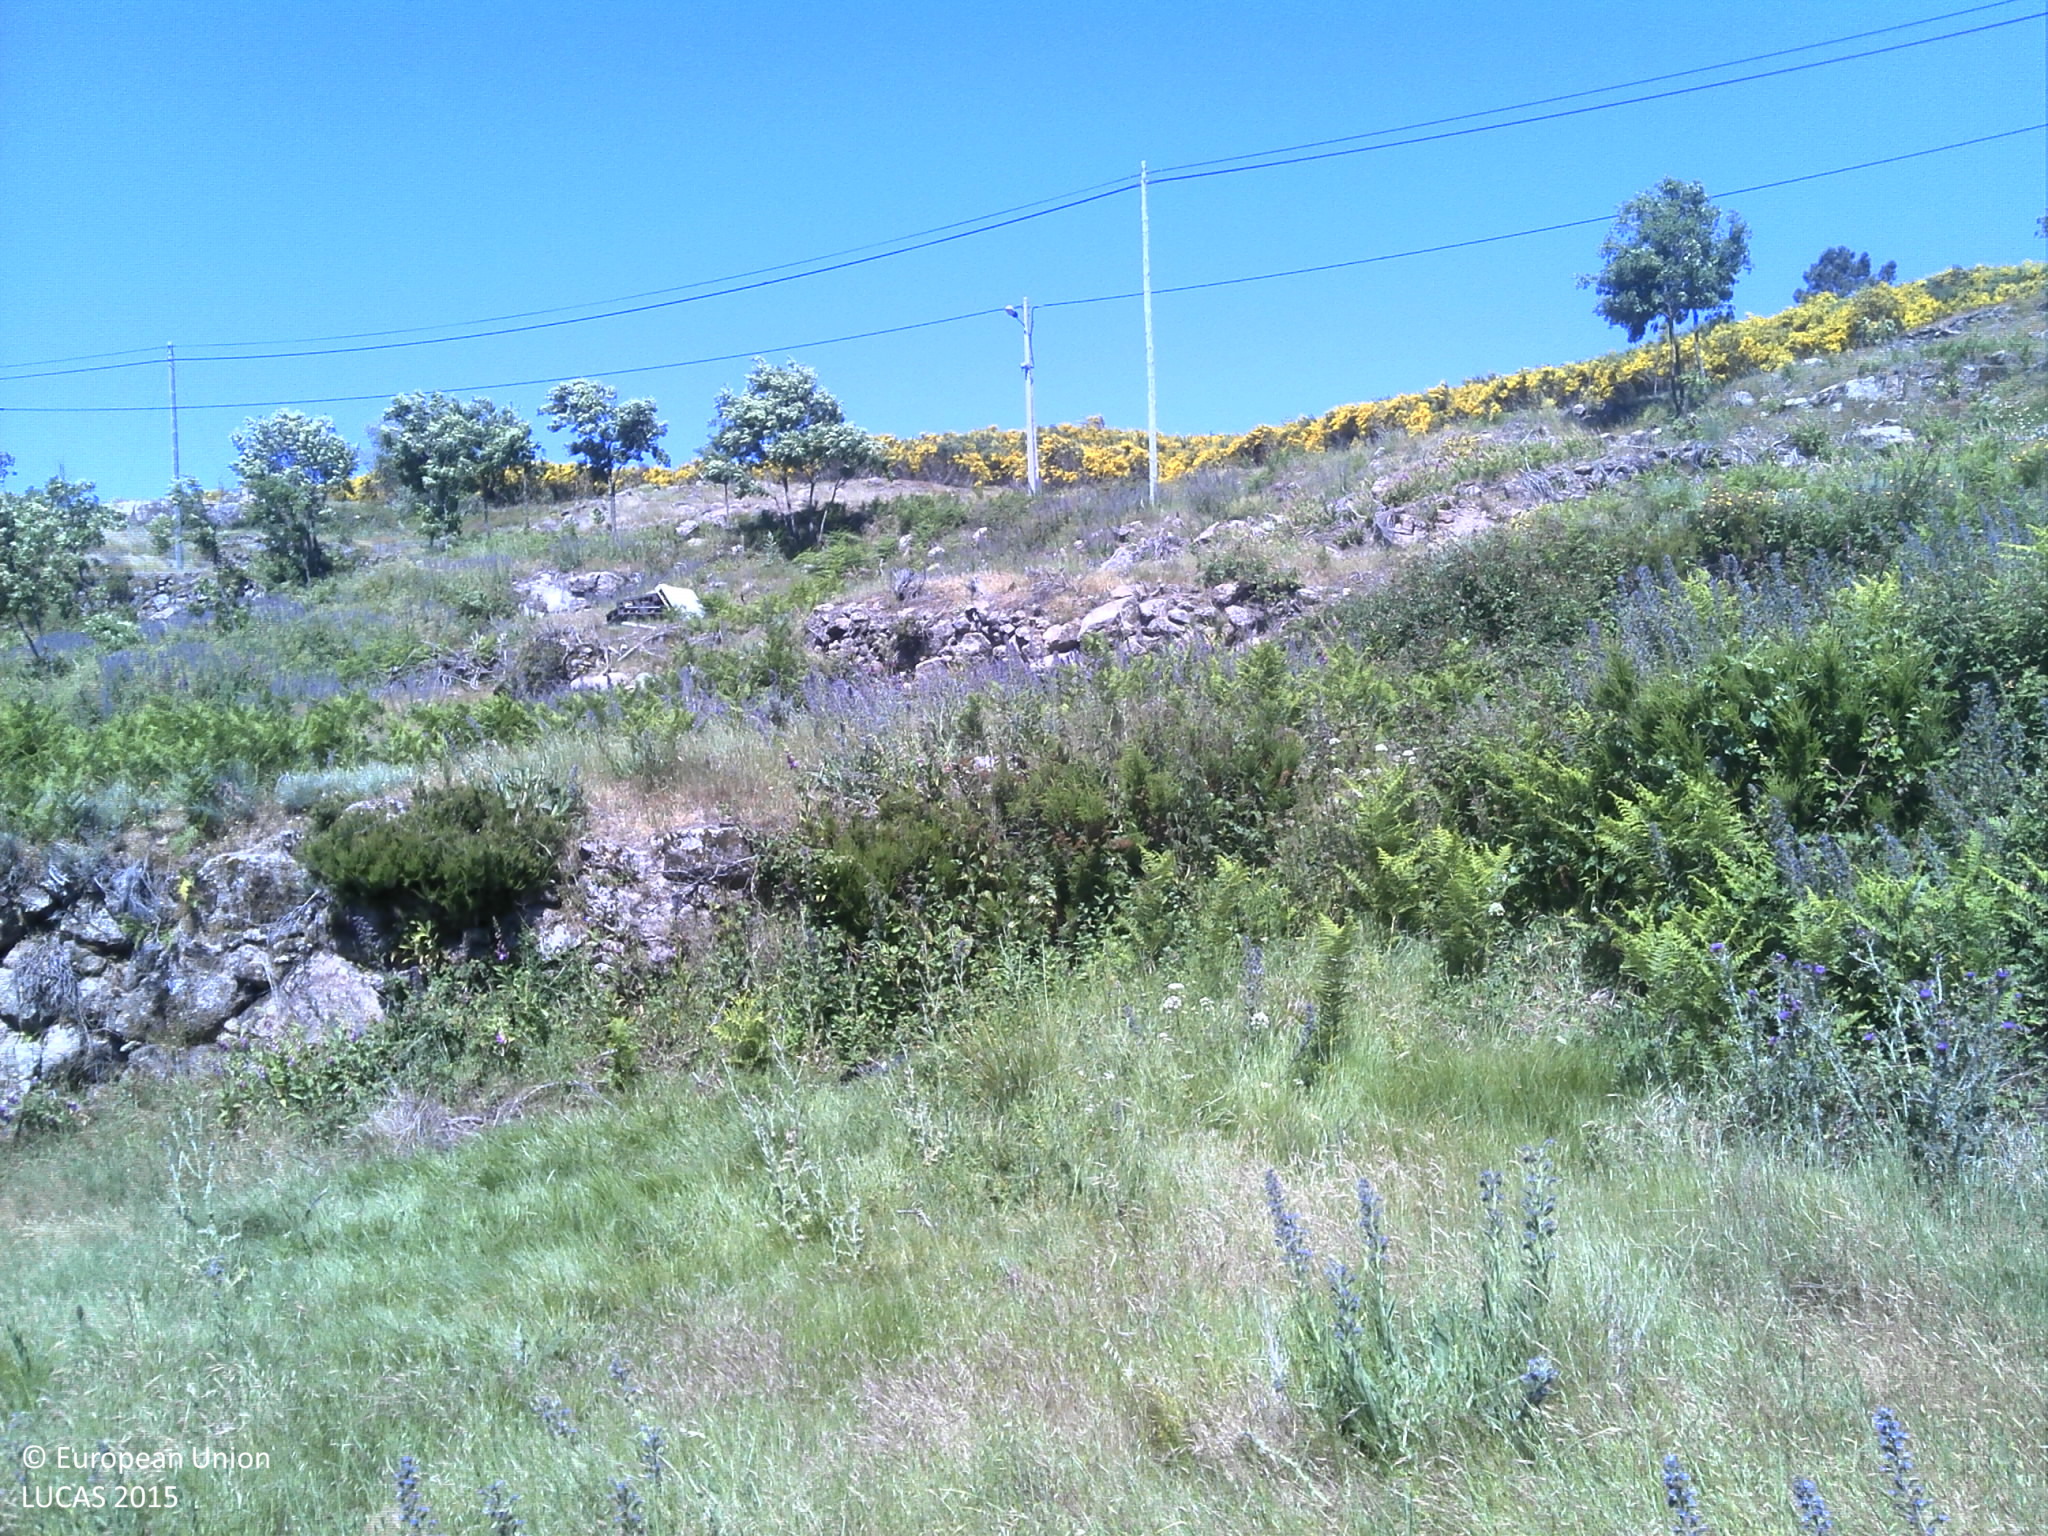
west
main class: Shrubland
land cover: Shrubland without tree cover
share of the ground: 50 - 75 %
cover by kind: shrubs 50 %, herbaceous plants 40 %, unconsolidated bare surface 10 %
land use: Semi-natural and natural areas not in use
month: May
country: PT
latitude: 40.4933
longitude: -7.2722
